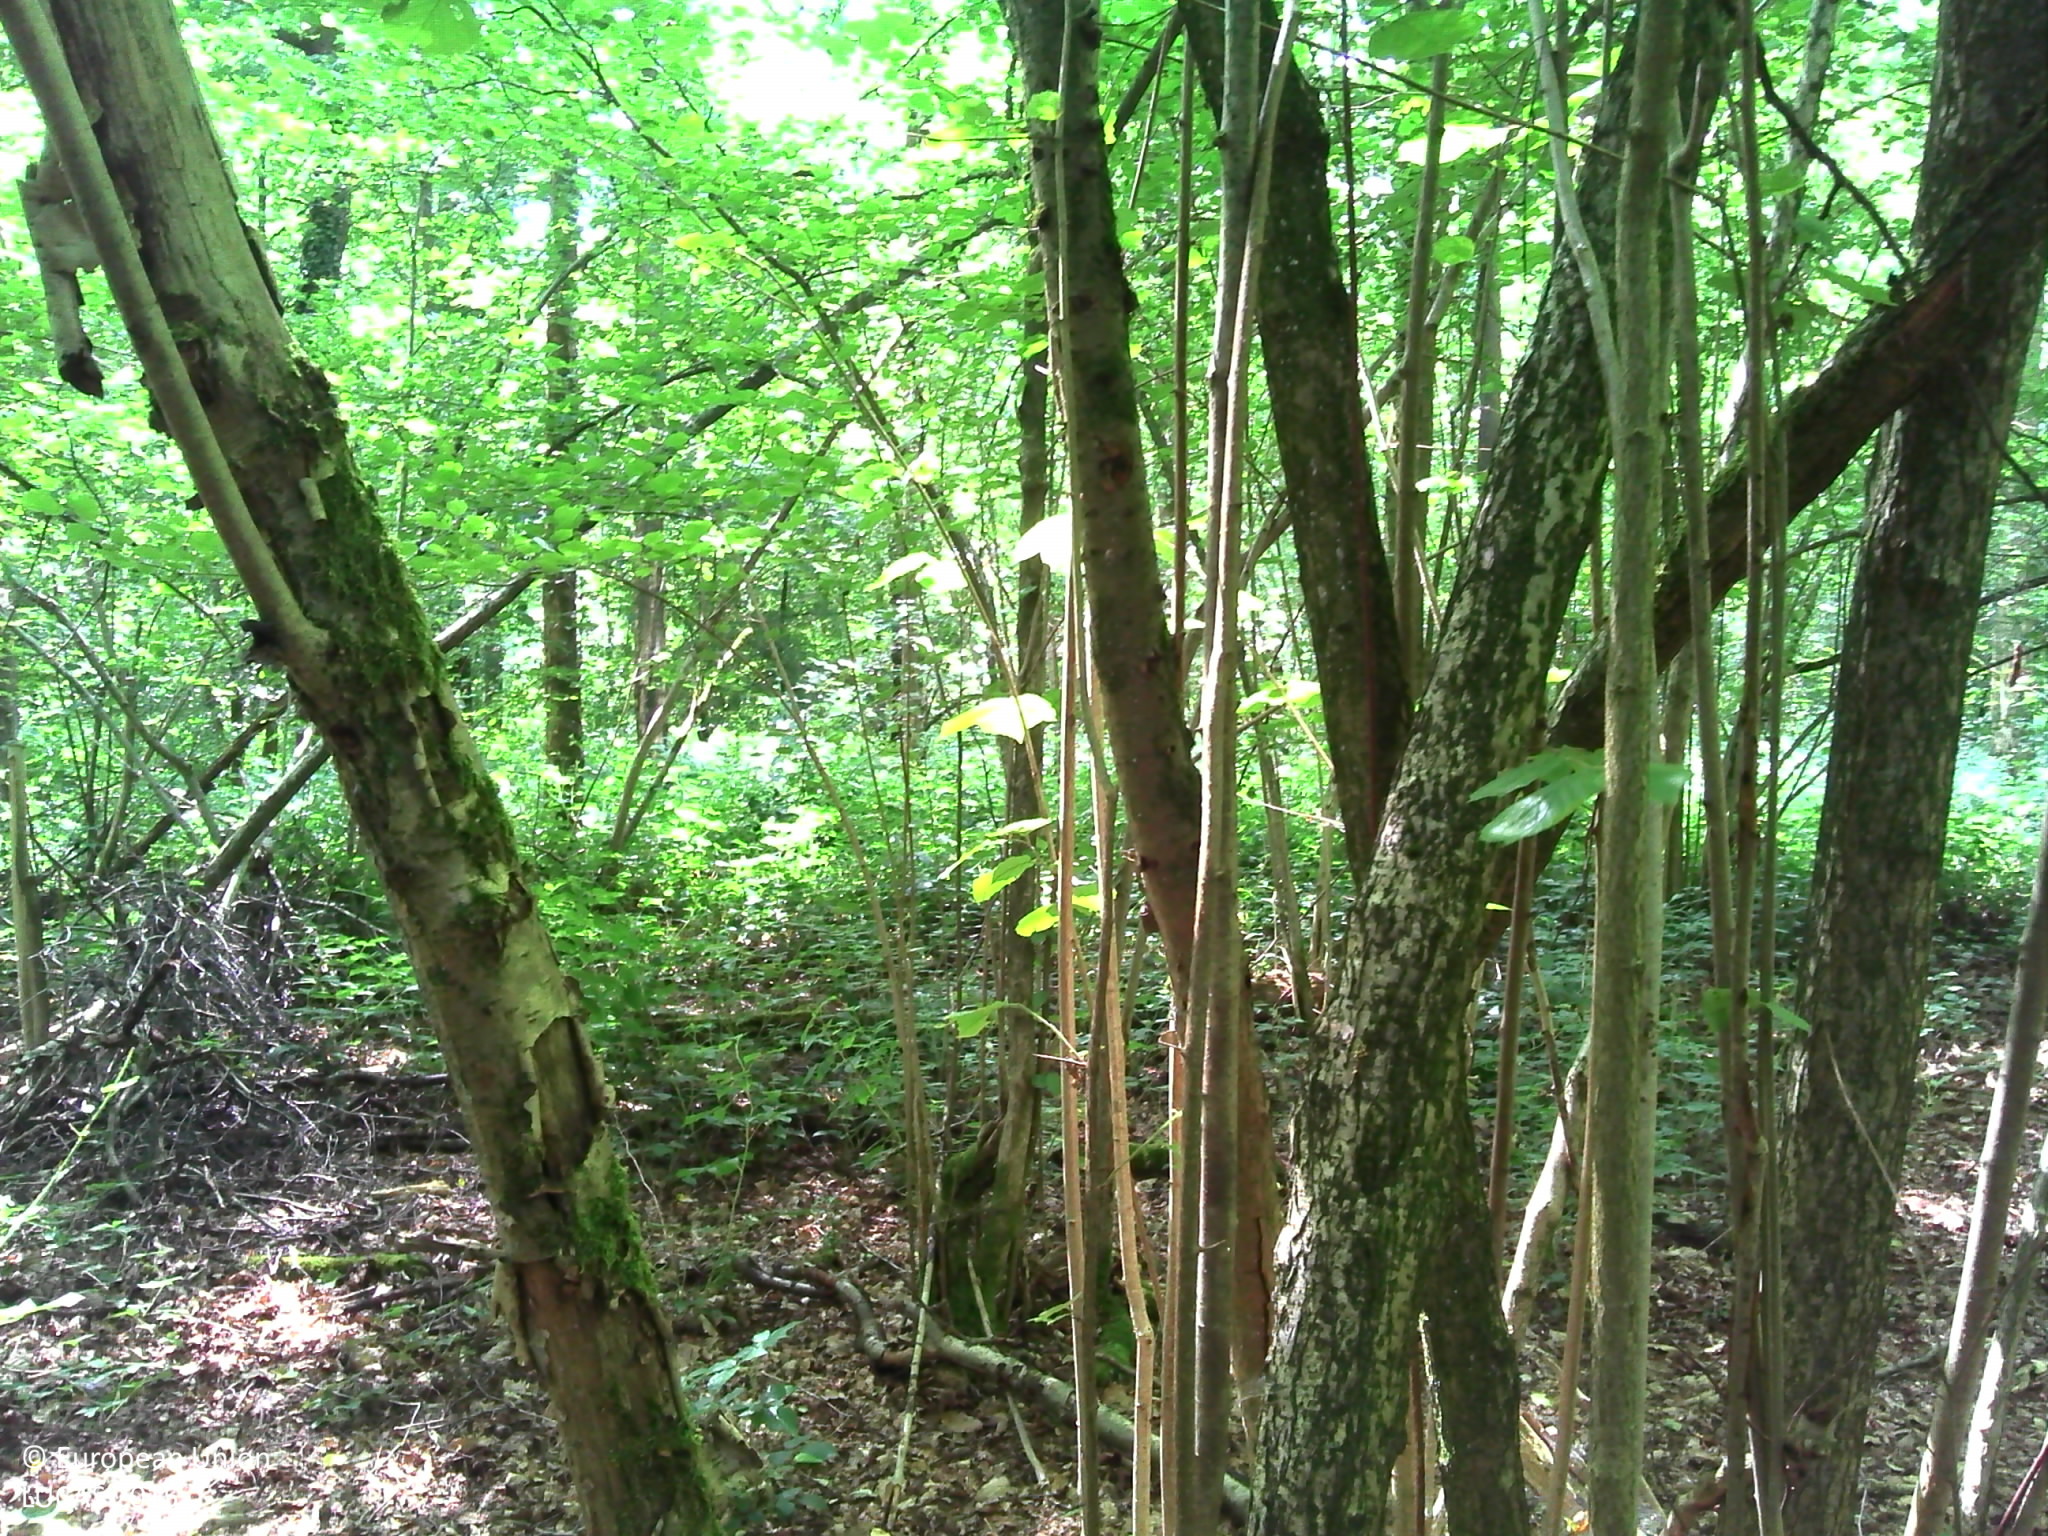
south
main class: Woodland
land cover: Broadleaved woodland
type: mesophytic deciduous forest
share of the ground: > 75 %
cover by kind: broadleaved forest trees 95 %, herbaceous plants 5 %
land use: Forestry
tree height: > 5 m
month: July
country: BE
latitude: 50.2172
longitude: 4.5725
